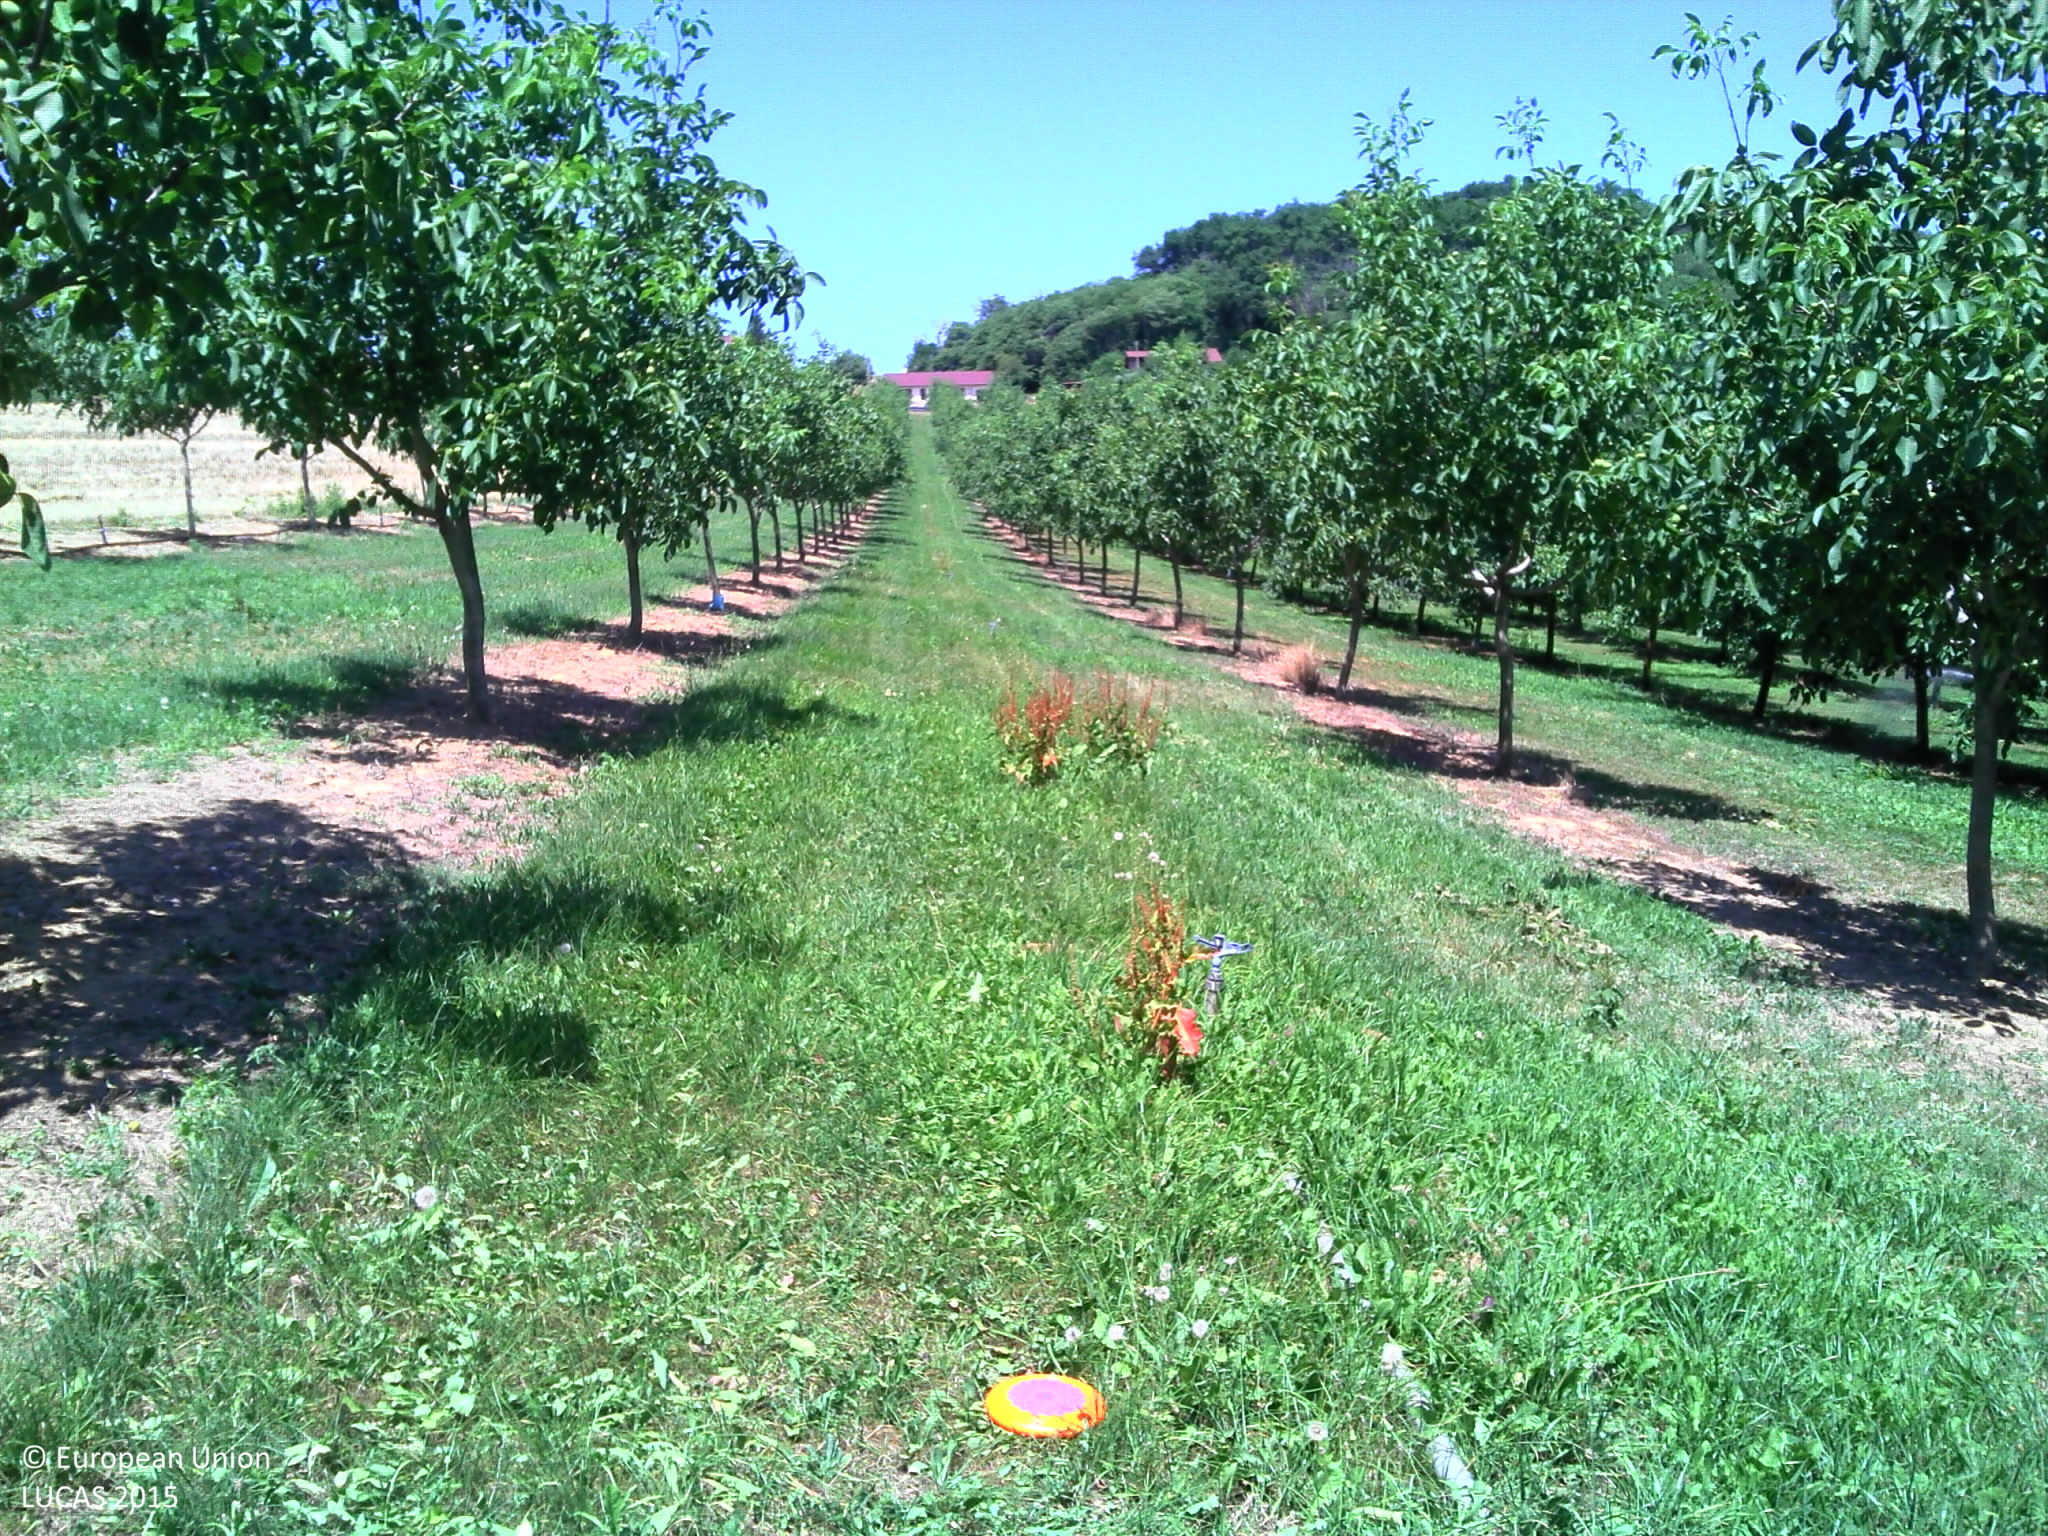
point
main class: Cropland
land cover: Nuts trees
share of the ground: 25 - 50 %
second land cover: Grassland without tree/shrub cover
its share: > 75 %
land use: Agriculture (excluding fallow land and kitchen gardens)
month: July
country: FR
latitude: 45.1430
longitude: 5.2108
